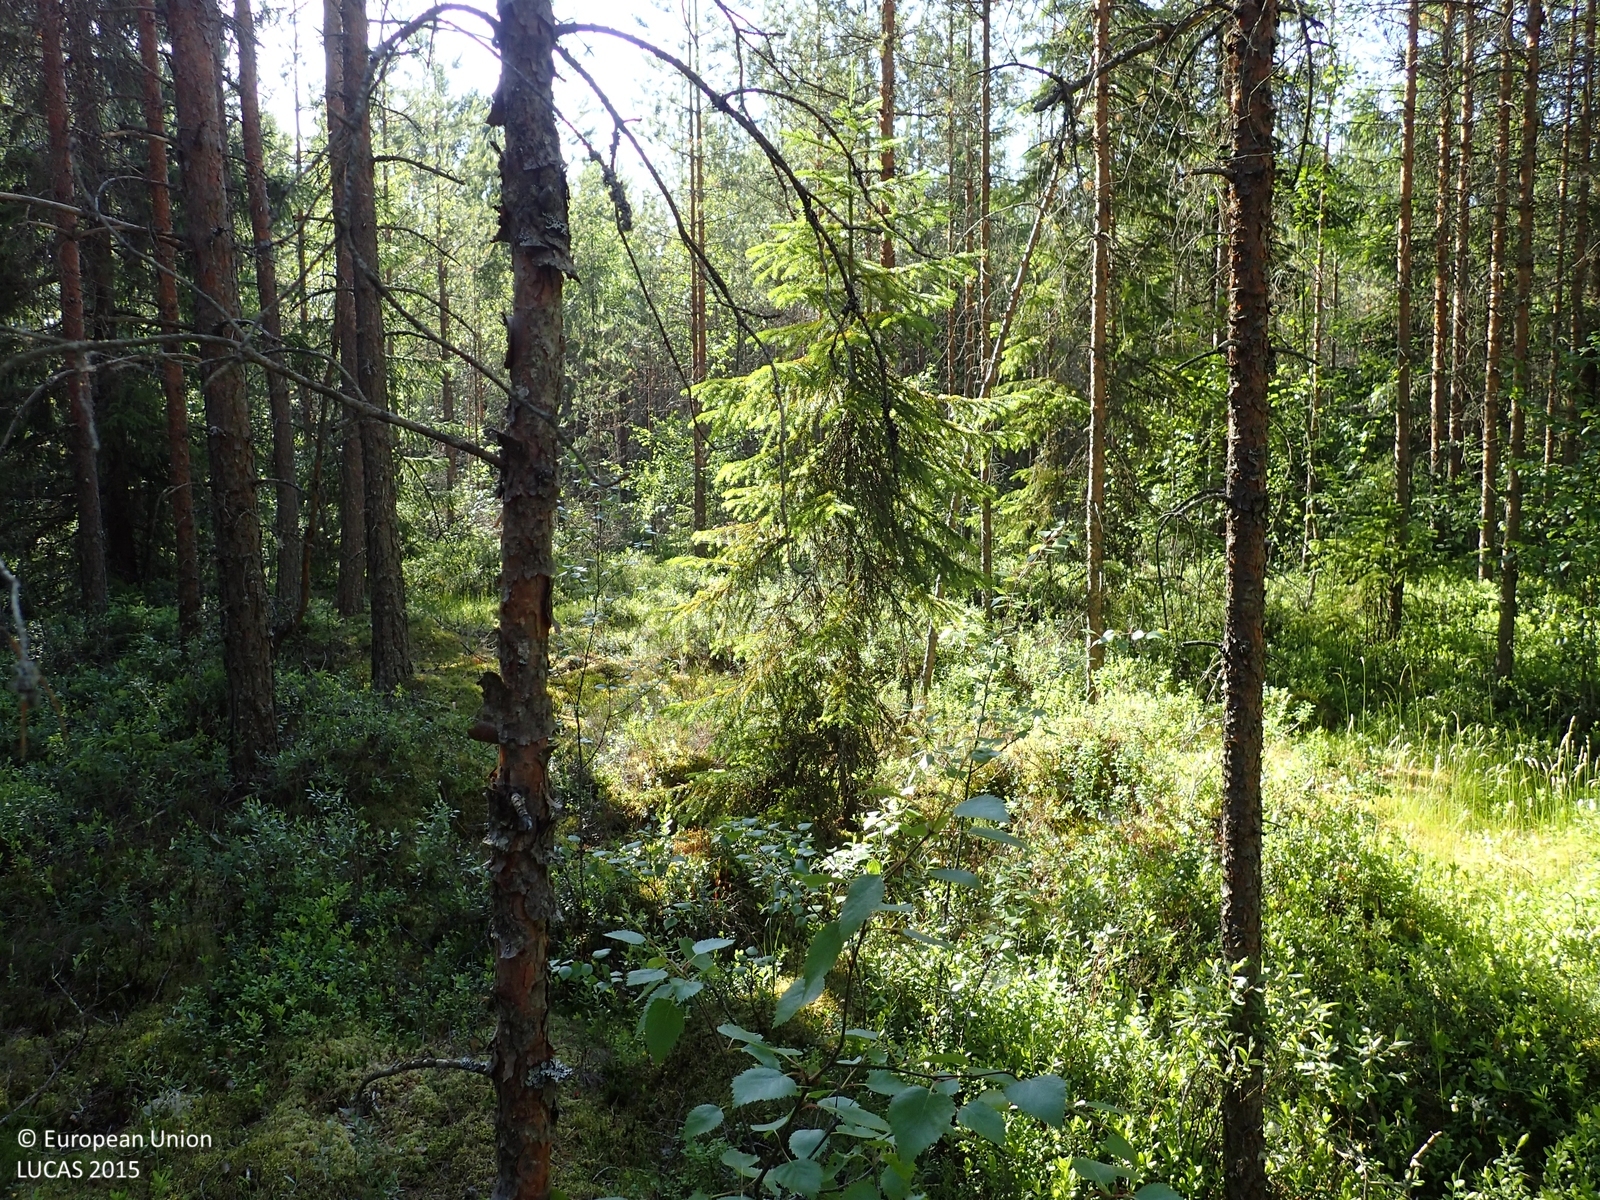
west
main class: Woodland
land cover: Pine dominated coniferous woodland
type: boreal forest
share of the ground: 50 - 75 %
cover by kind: coniferous forest trees 50 %, shrubs 45 %, broadleaved forest trees 5 %
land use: Forestry
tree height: > 5 m
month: July
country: FI
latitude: 62.7046
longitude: 21.6739
